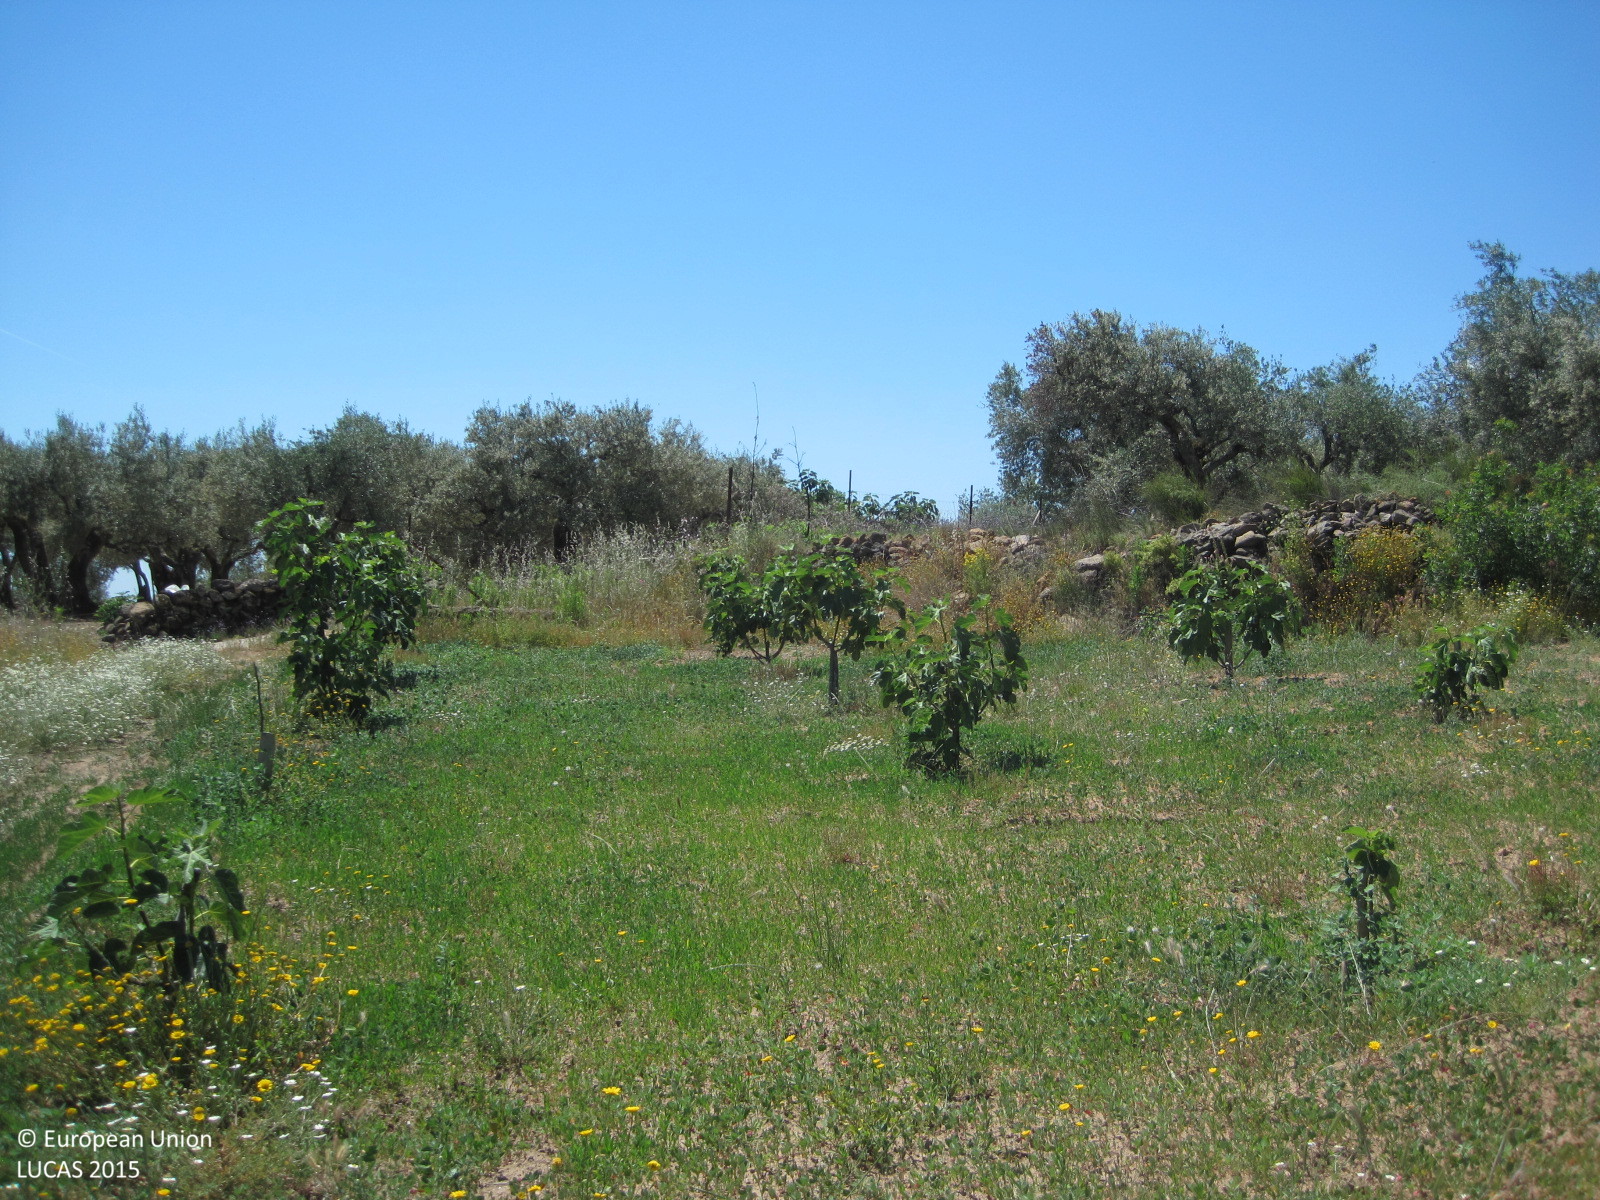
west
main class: Cropland
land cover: Other fruit trees and berries
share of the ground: < 10 %
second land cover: Grassland without tree/shrub cover
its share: 50 - 75 %
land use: Agriculture (excluding fallow land and kitchen gardens)
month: May
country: ES
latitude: 40.1642
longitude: -5.1676
